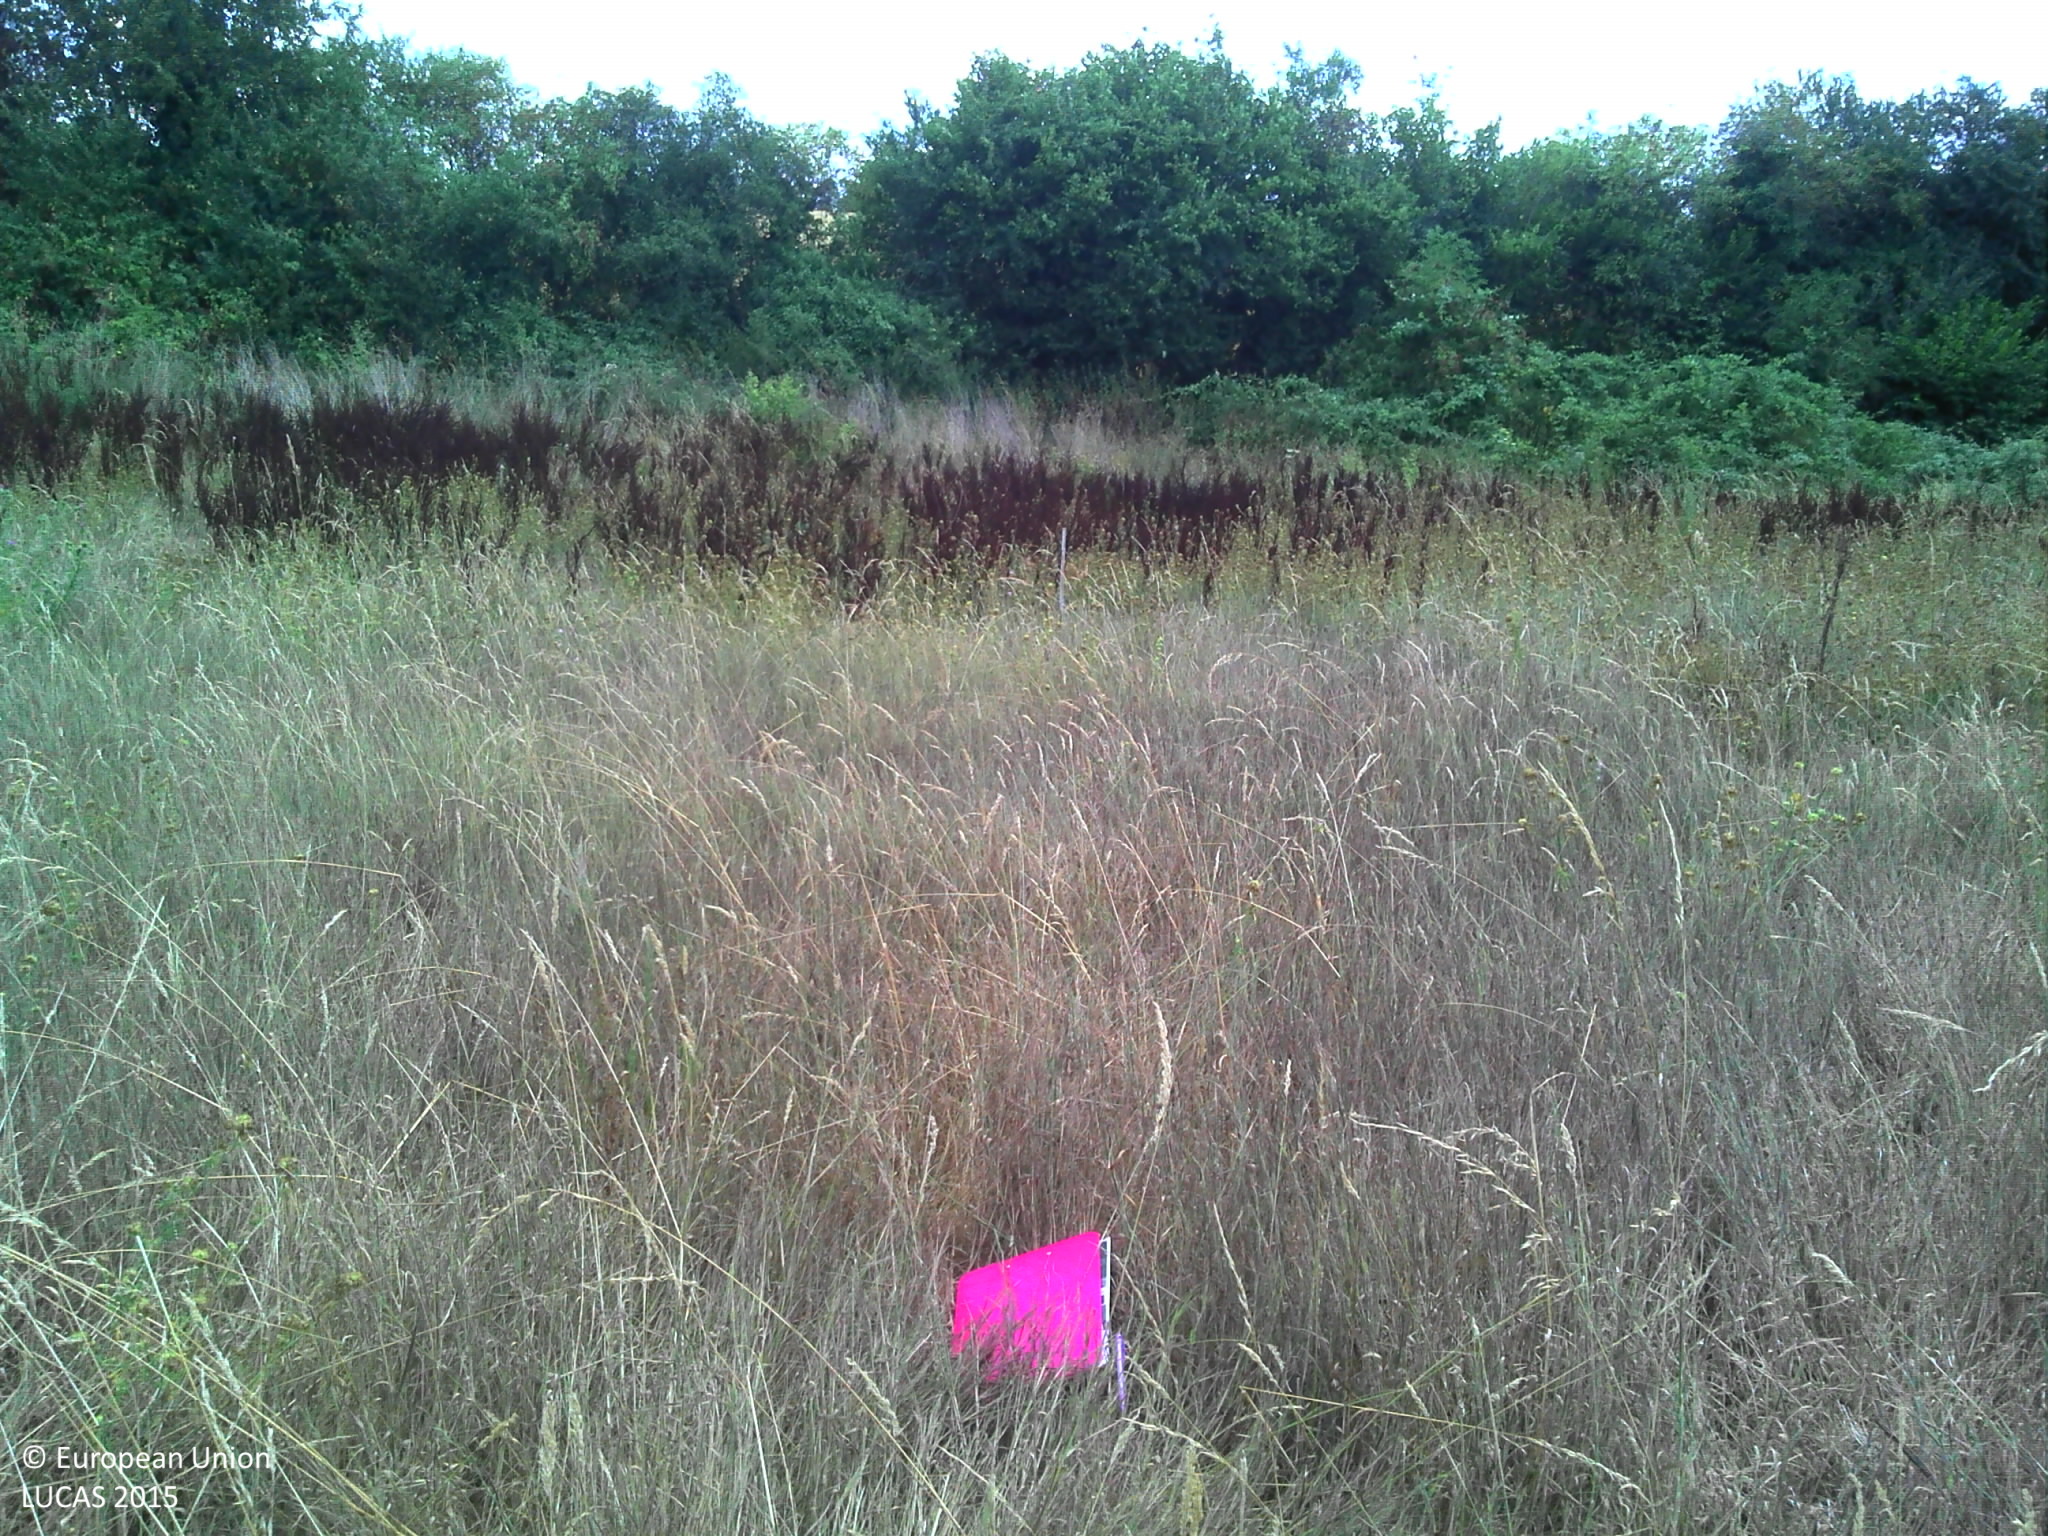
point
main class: Grassland
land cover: Grassland without tree/shrub cover
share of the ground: > 75 %
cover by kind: herbaceous plants 100 %
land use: Agriculture (excluding fallow land and kitchen gardens)
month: July
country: FR
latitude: 45.9327
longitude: 0.9736
